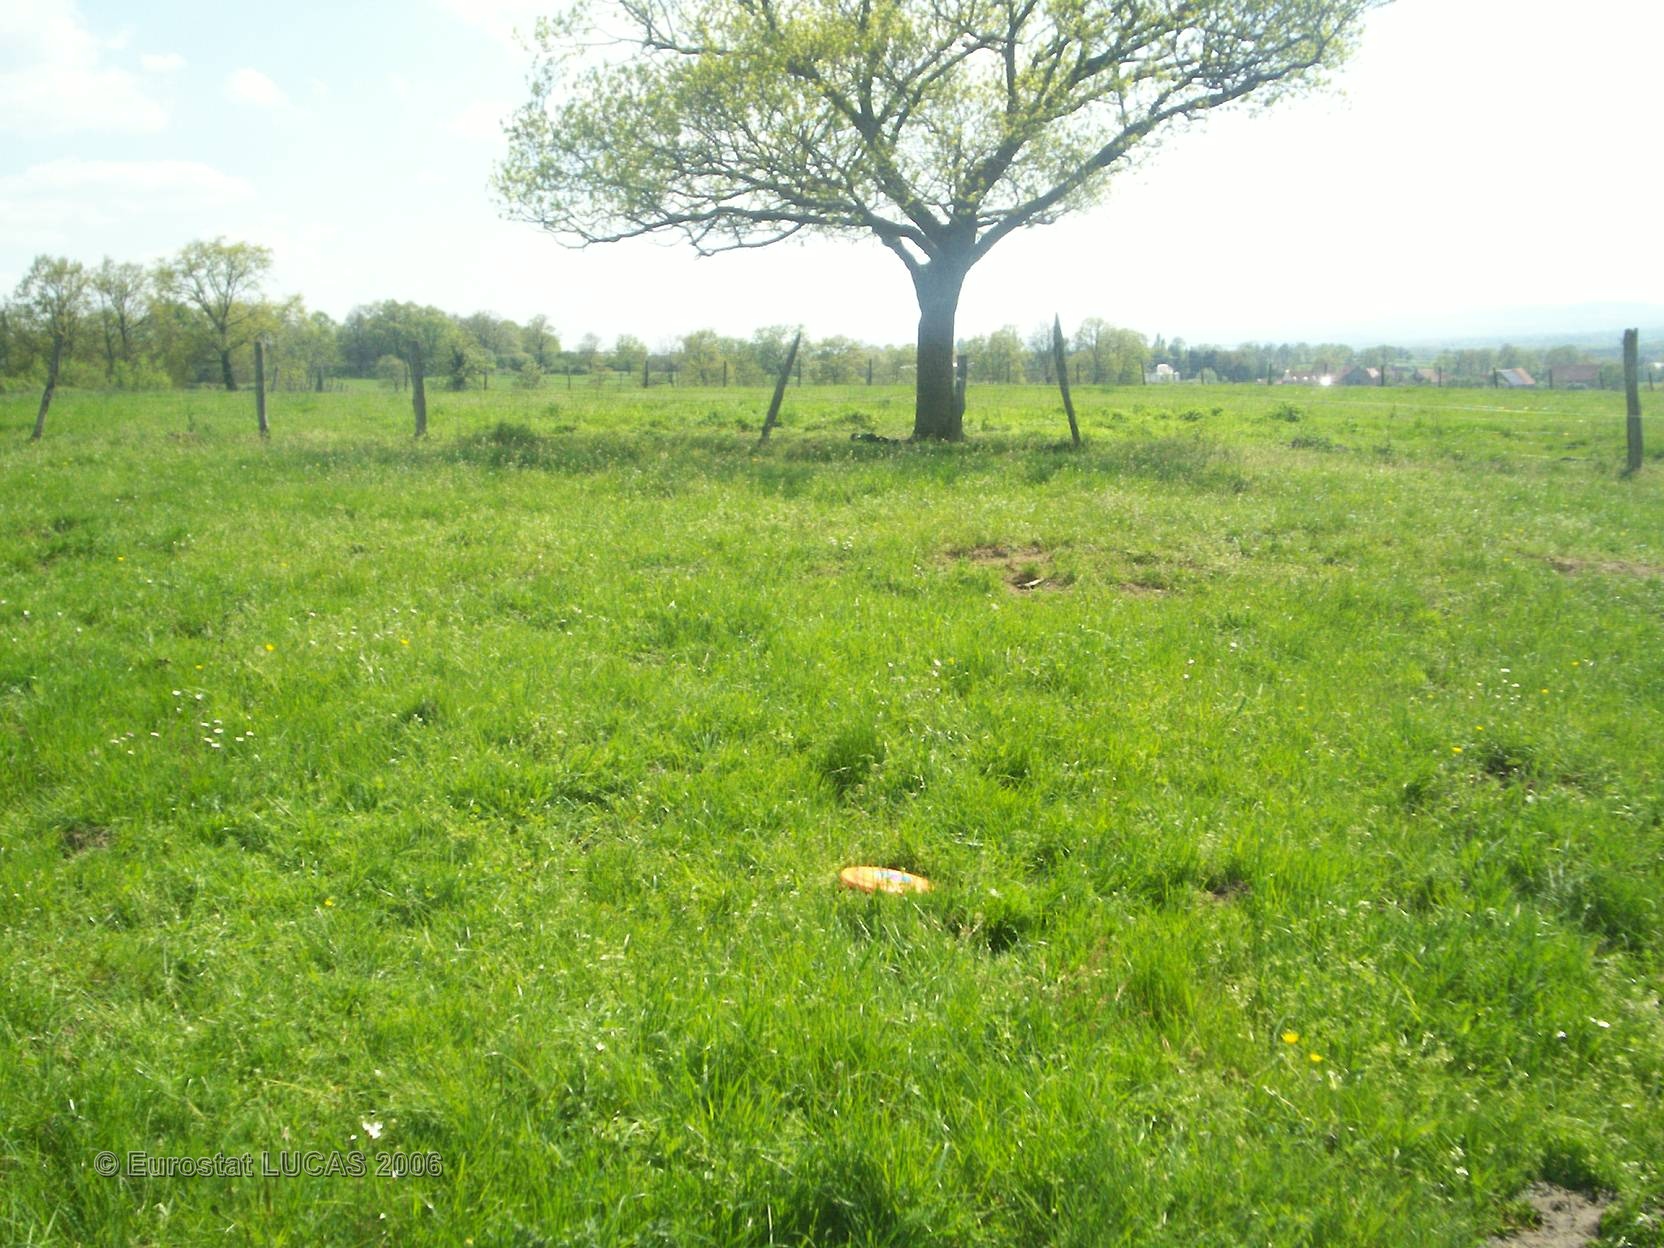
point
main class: Grassland
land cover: Grassland without tree/shrub cover
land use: Agriculture (excluding fallow land and kitchen gardens)
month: May
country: FR
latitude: 46.3288
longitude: 3.1266
